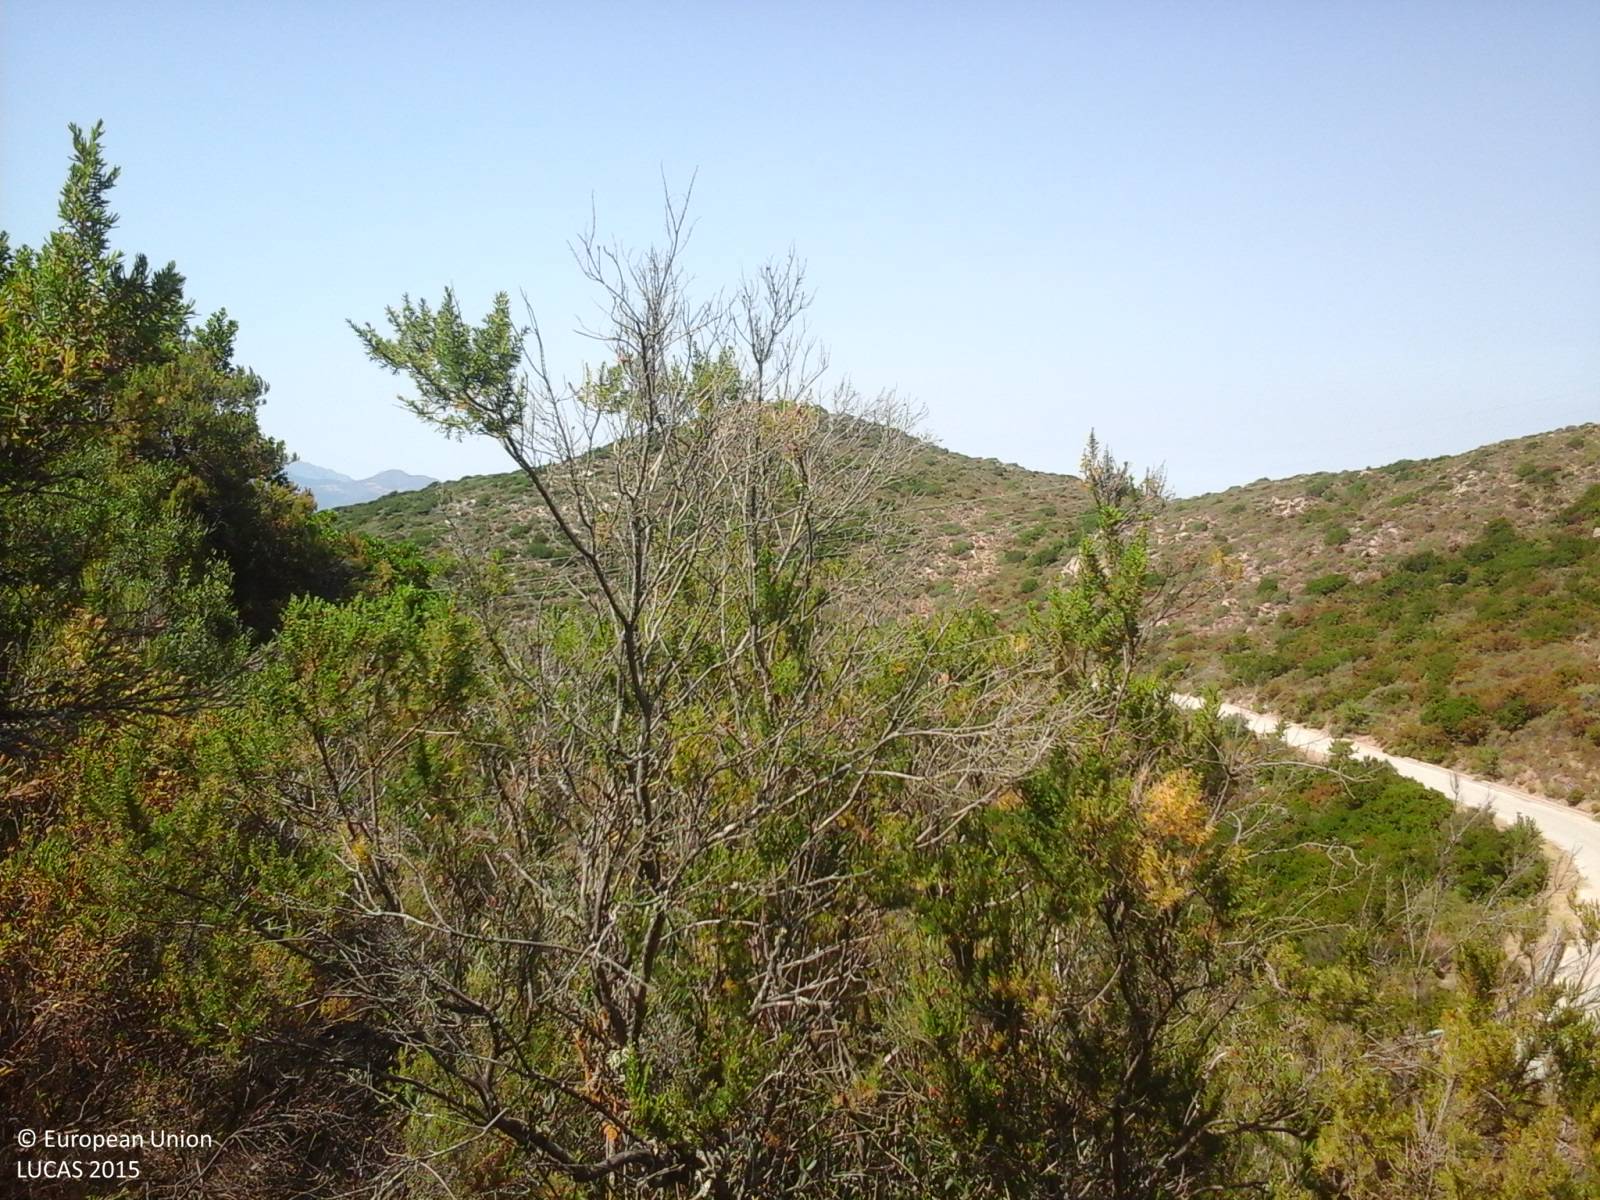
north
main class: Shrubland
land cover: Shrubland without tree cover
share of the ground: > 75 %
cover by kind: shrubs 95 %, herbaceous plants 5 %
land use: Semi-natural and natural areas not in use
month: June
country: IT
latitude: 40.5744
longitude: 9.6356
